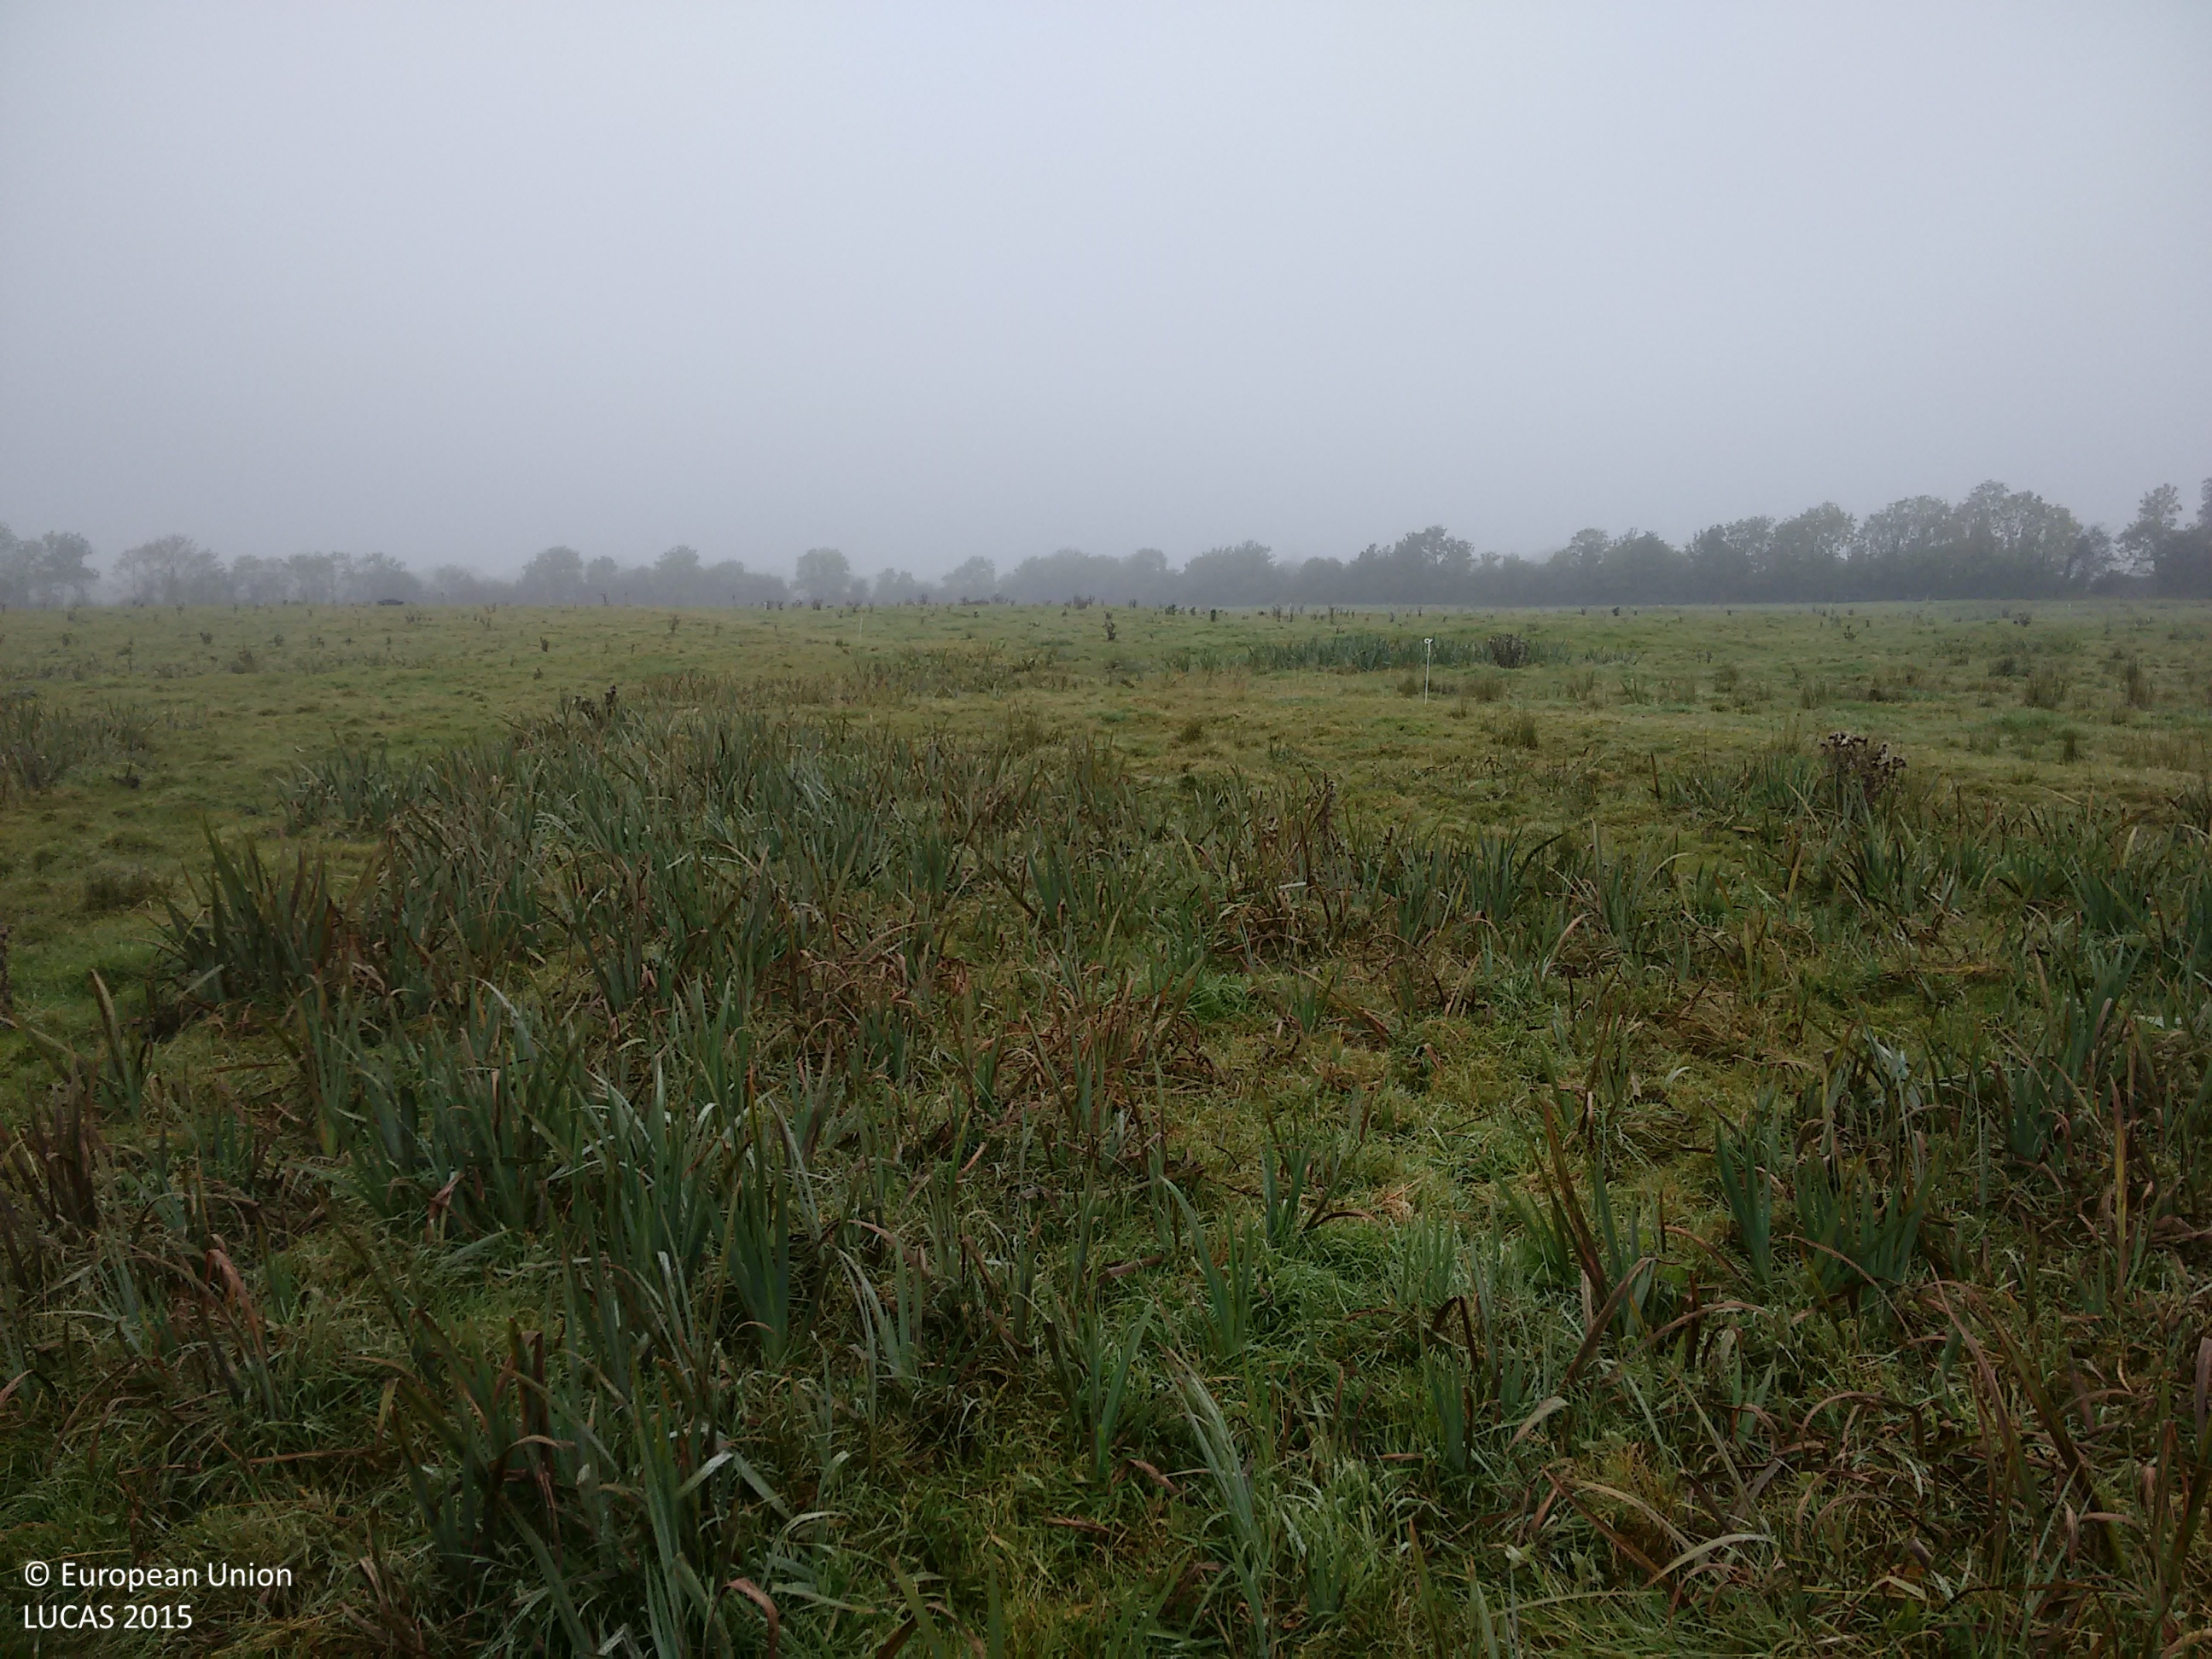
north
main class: Grassland
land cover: Grassland without tree/shrub cover
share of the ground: > 75 %
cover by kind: herbaceous plants 100 %
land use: Agriculture (excluding fallow land and kitchen gardens)
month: October
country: IE
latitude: 52.4667
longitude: -9.0105
